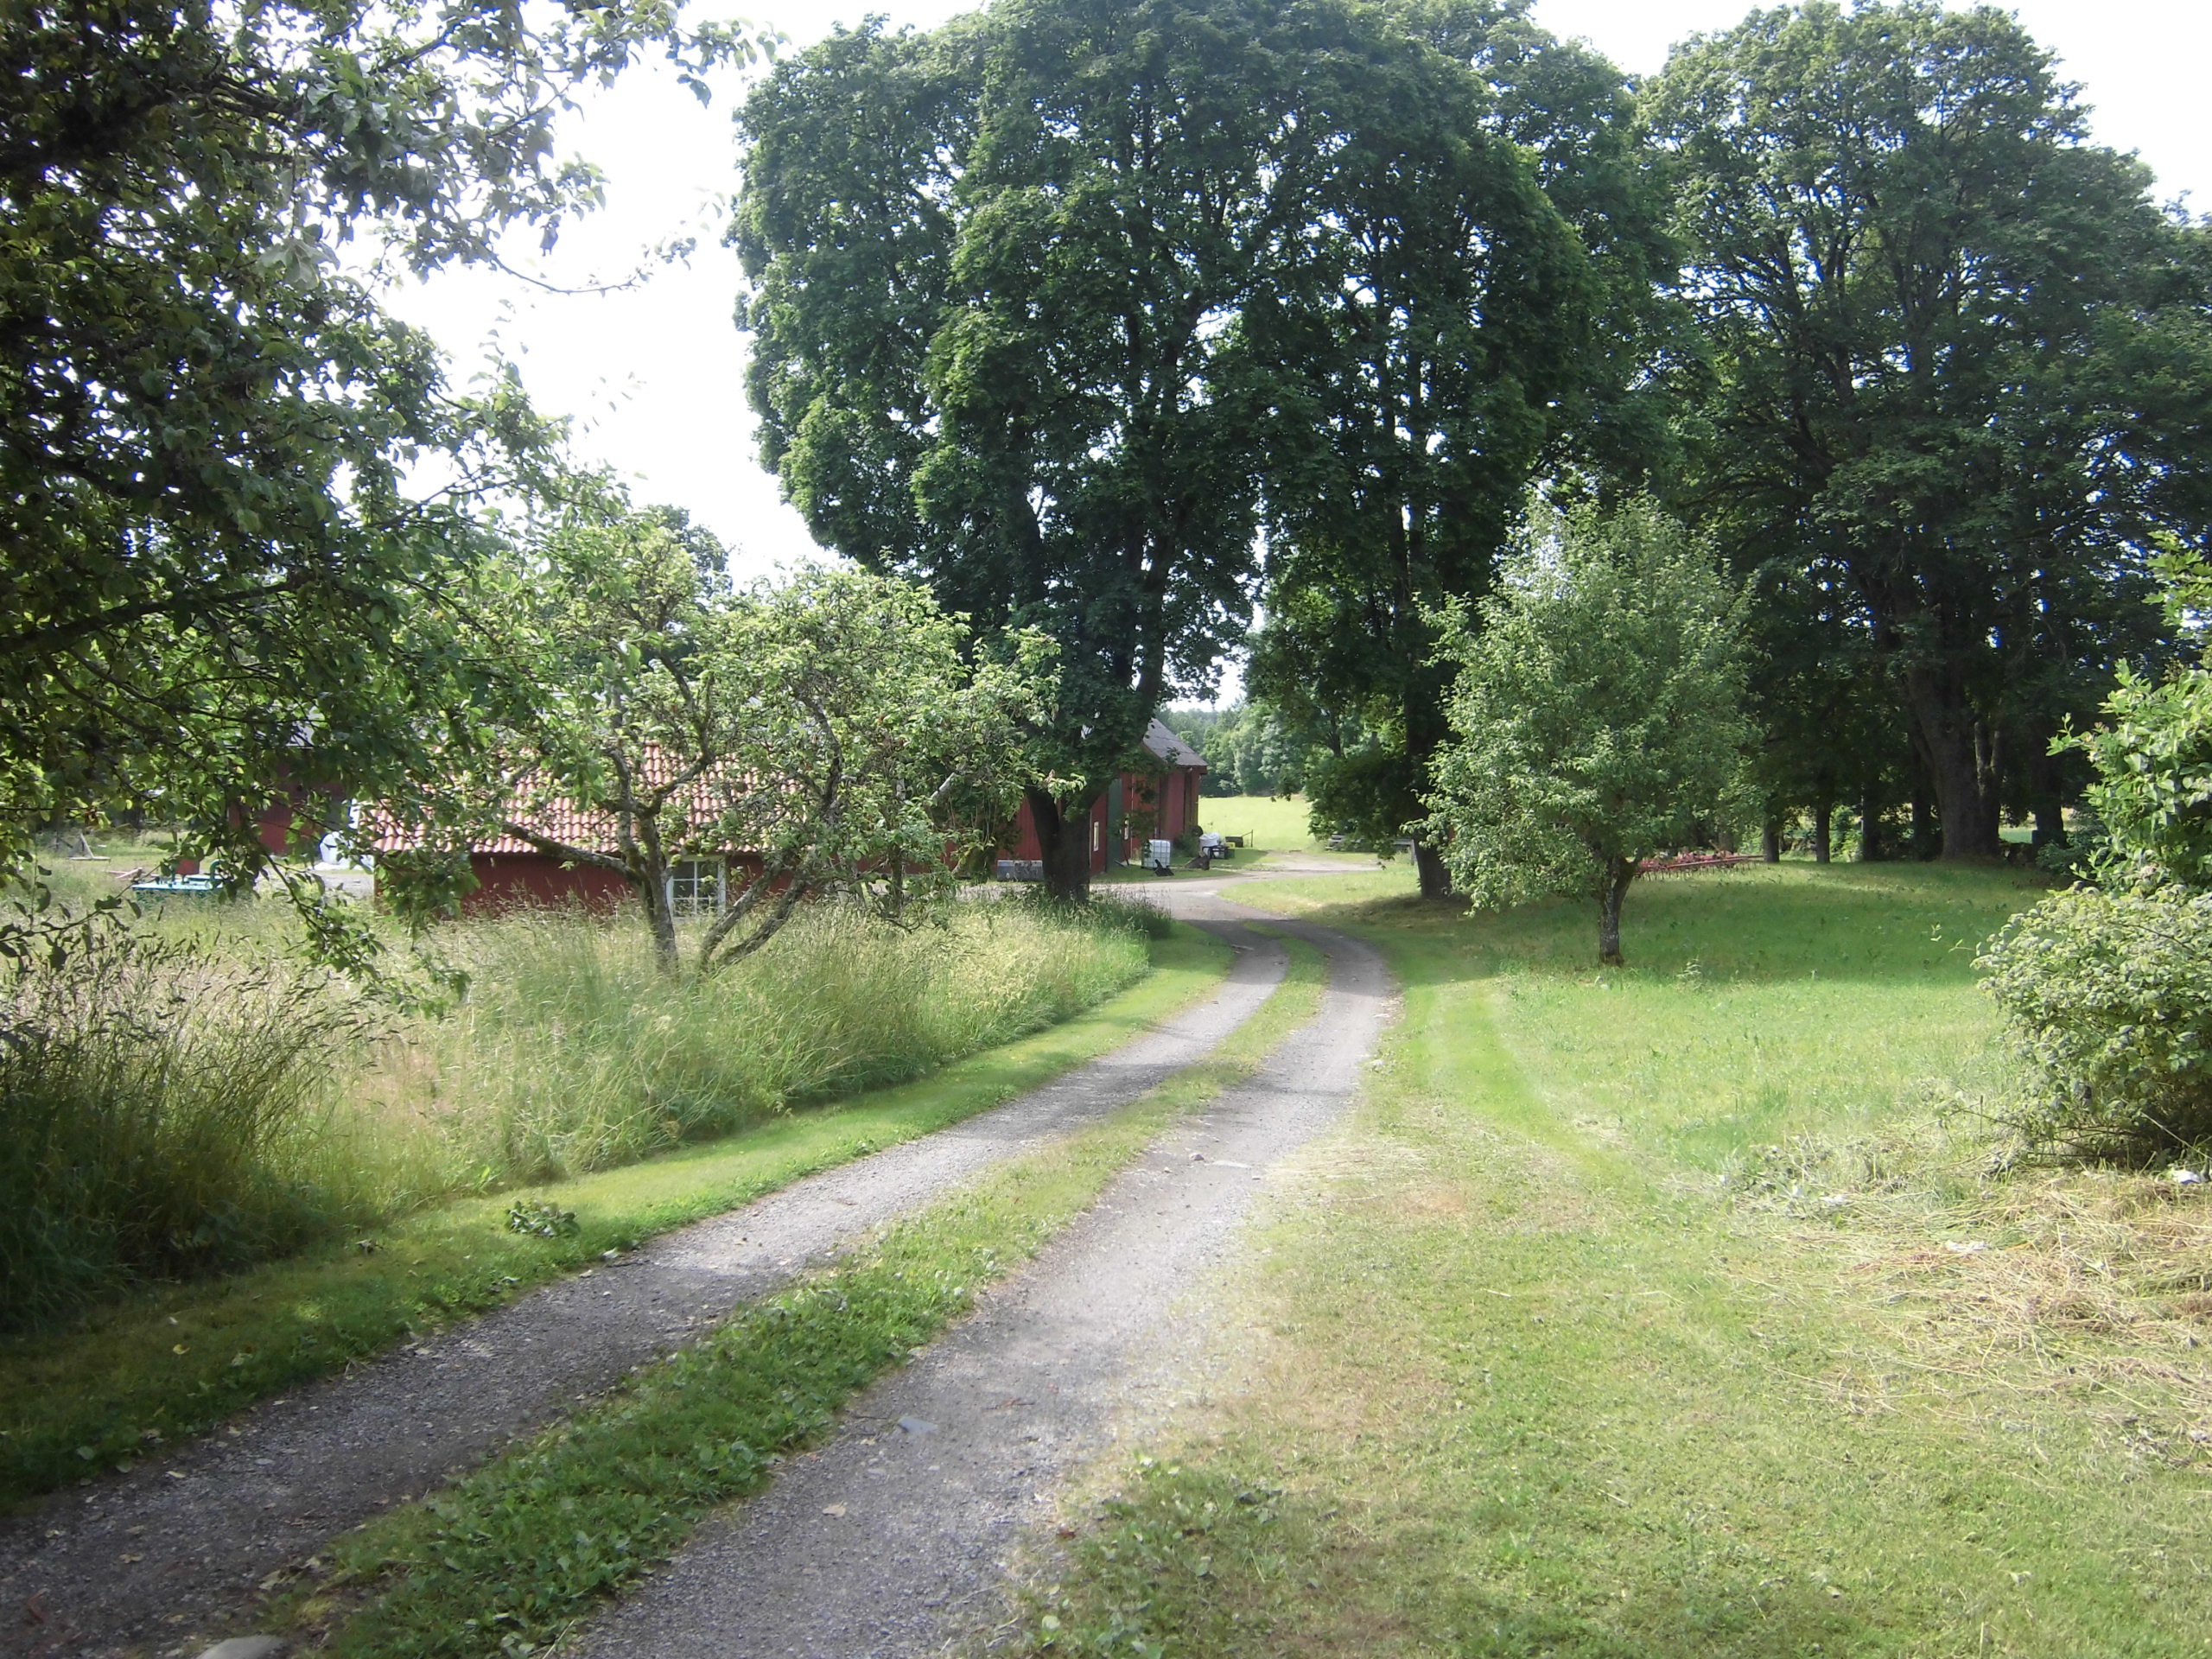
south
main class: Grassland
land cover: Grassland without tree/shrub cover
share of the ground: > 75 %
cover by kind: herbaceous plants 100 %
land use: Residential
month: July
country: SE
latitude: 57.1375
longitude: 15.4007
